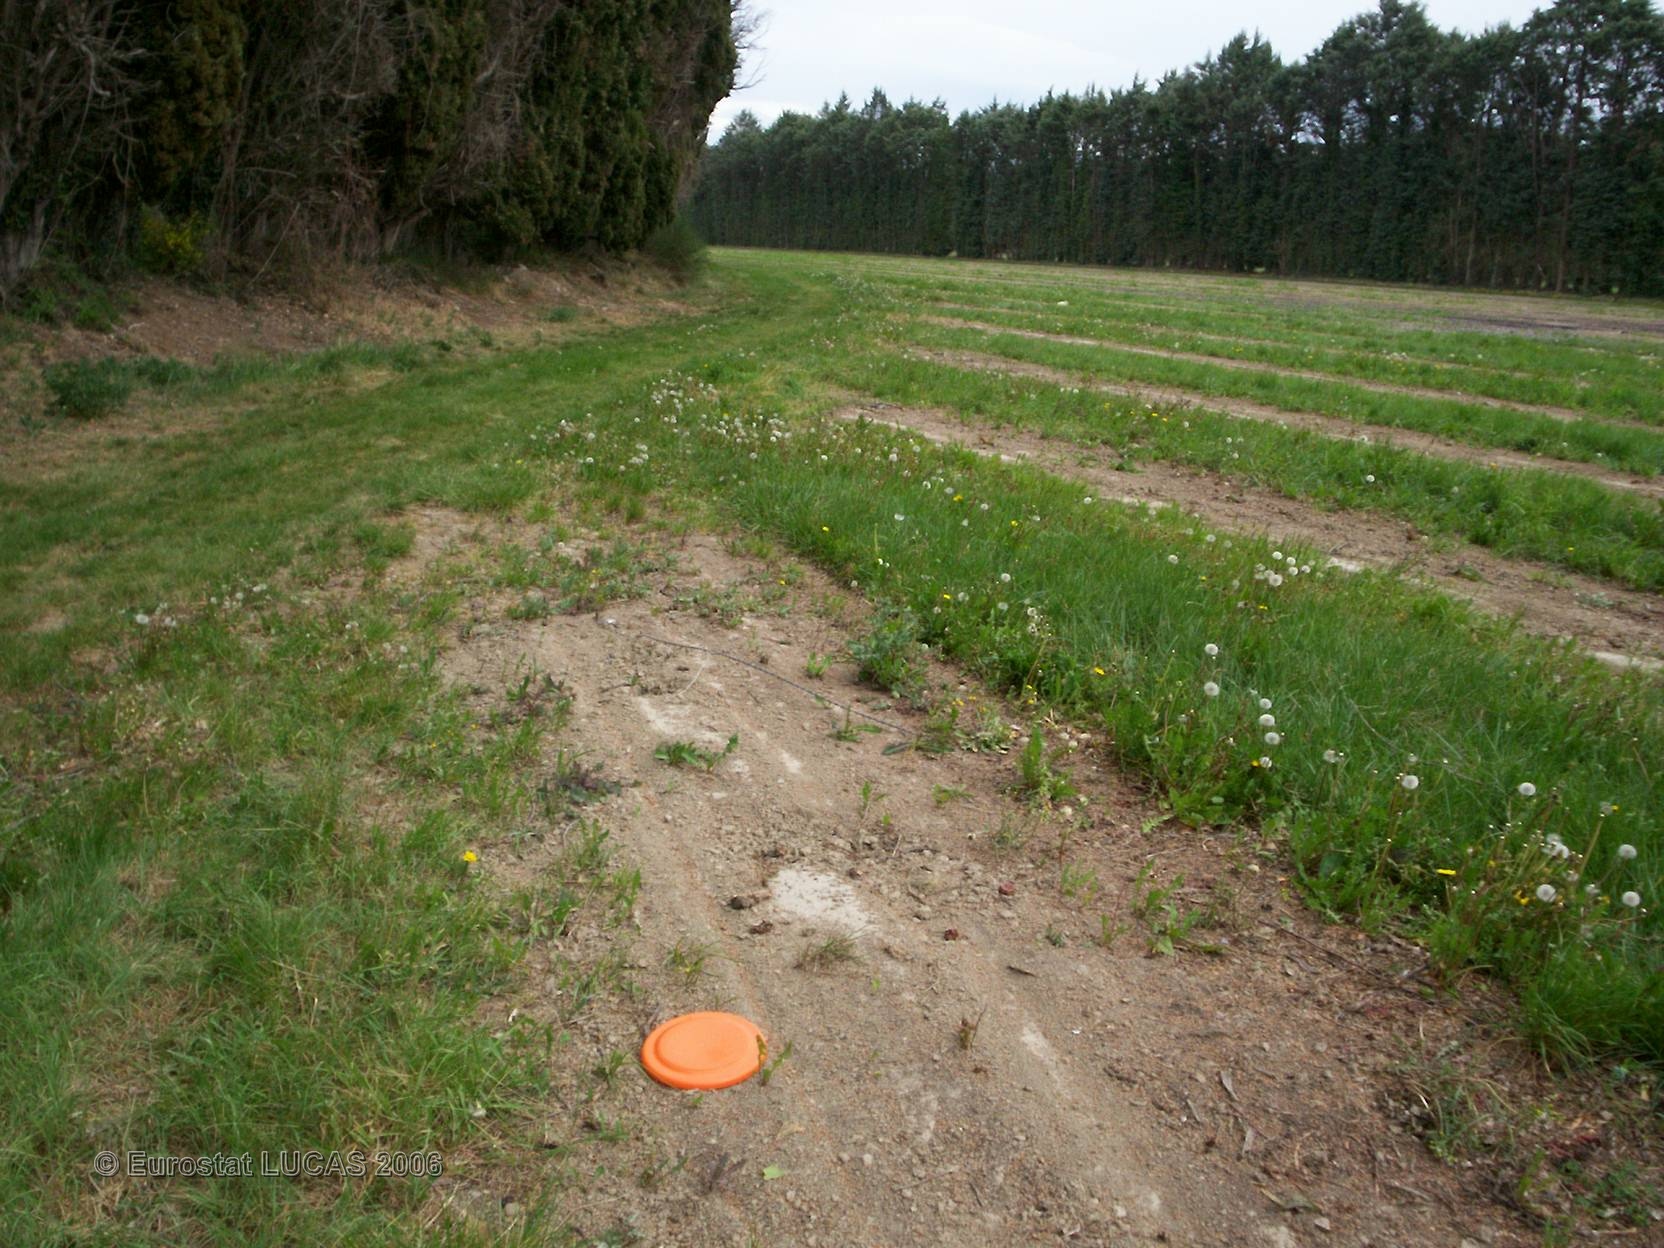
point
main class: Grassland
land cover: Grassland without tree/shrub cover
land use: Agriculture (excluding fallow land and kitchen gardens)
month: April
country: FR
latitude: 43.8312
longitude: 4.9725
